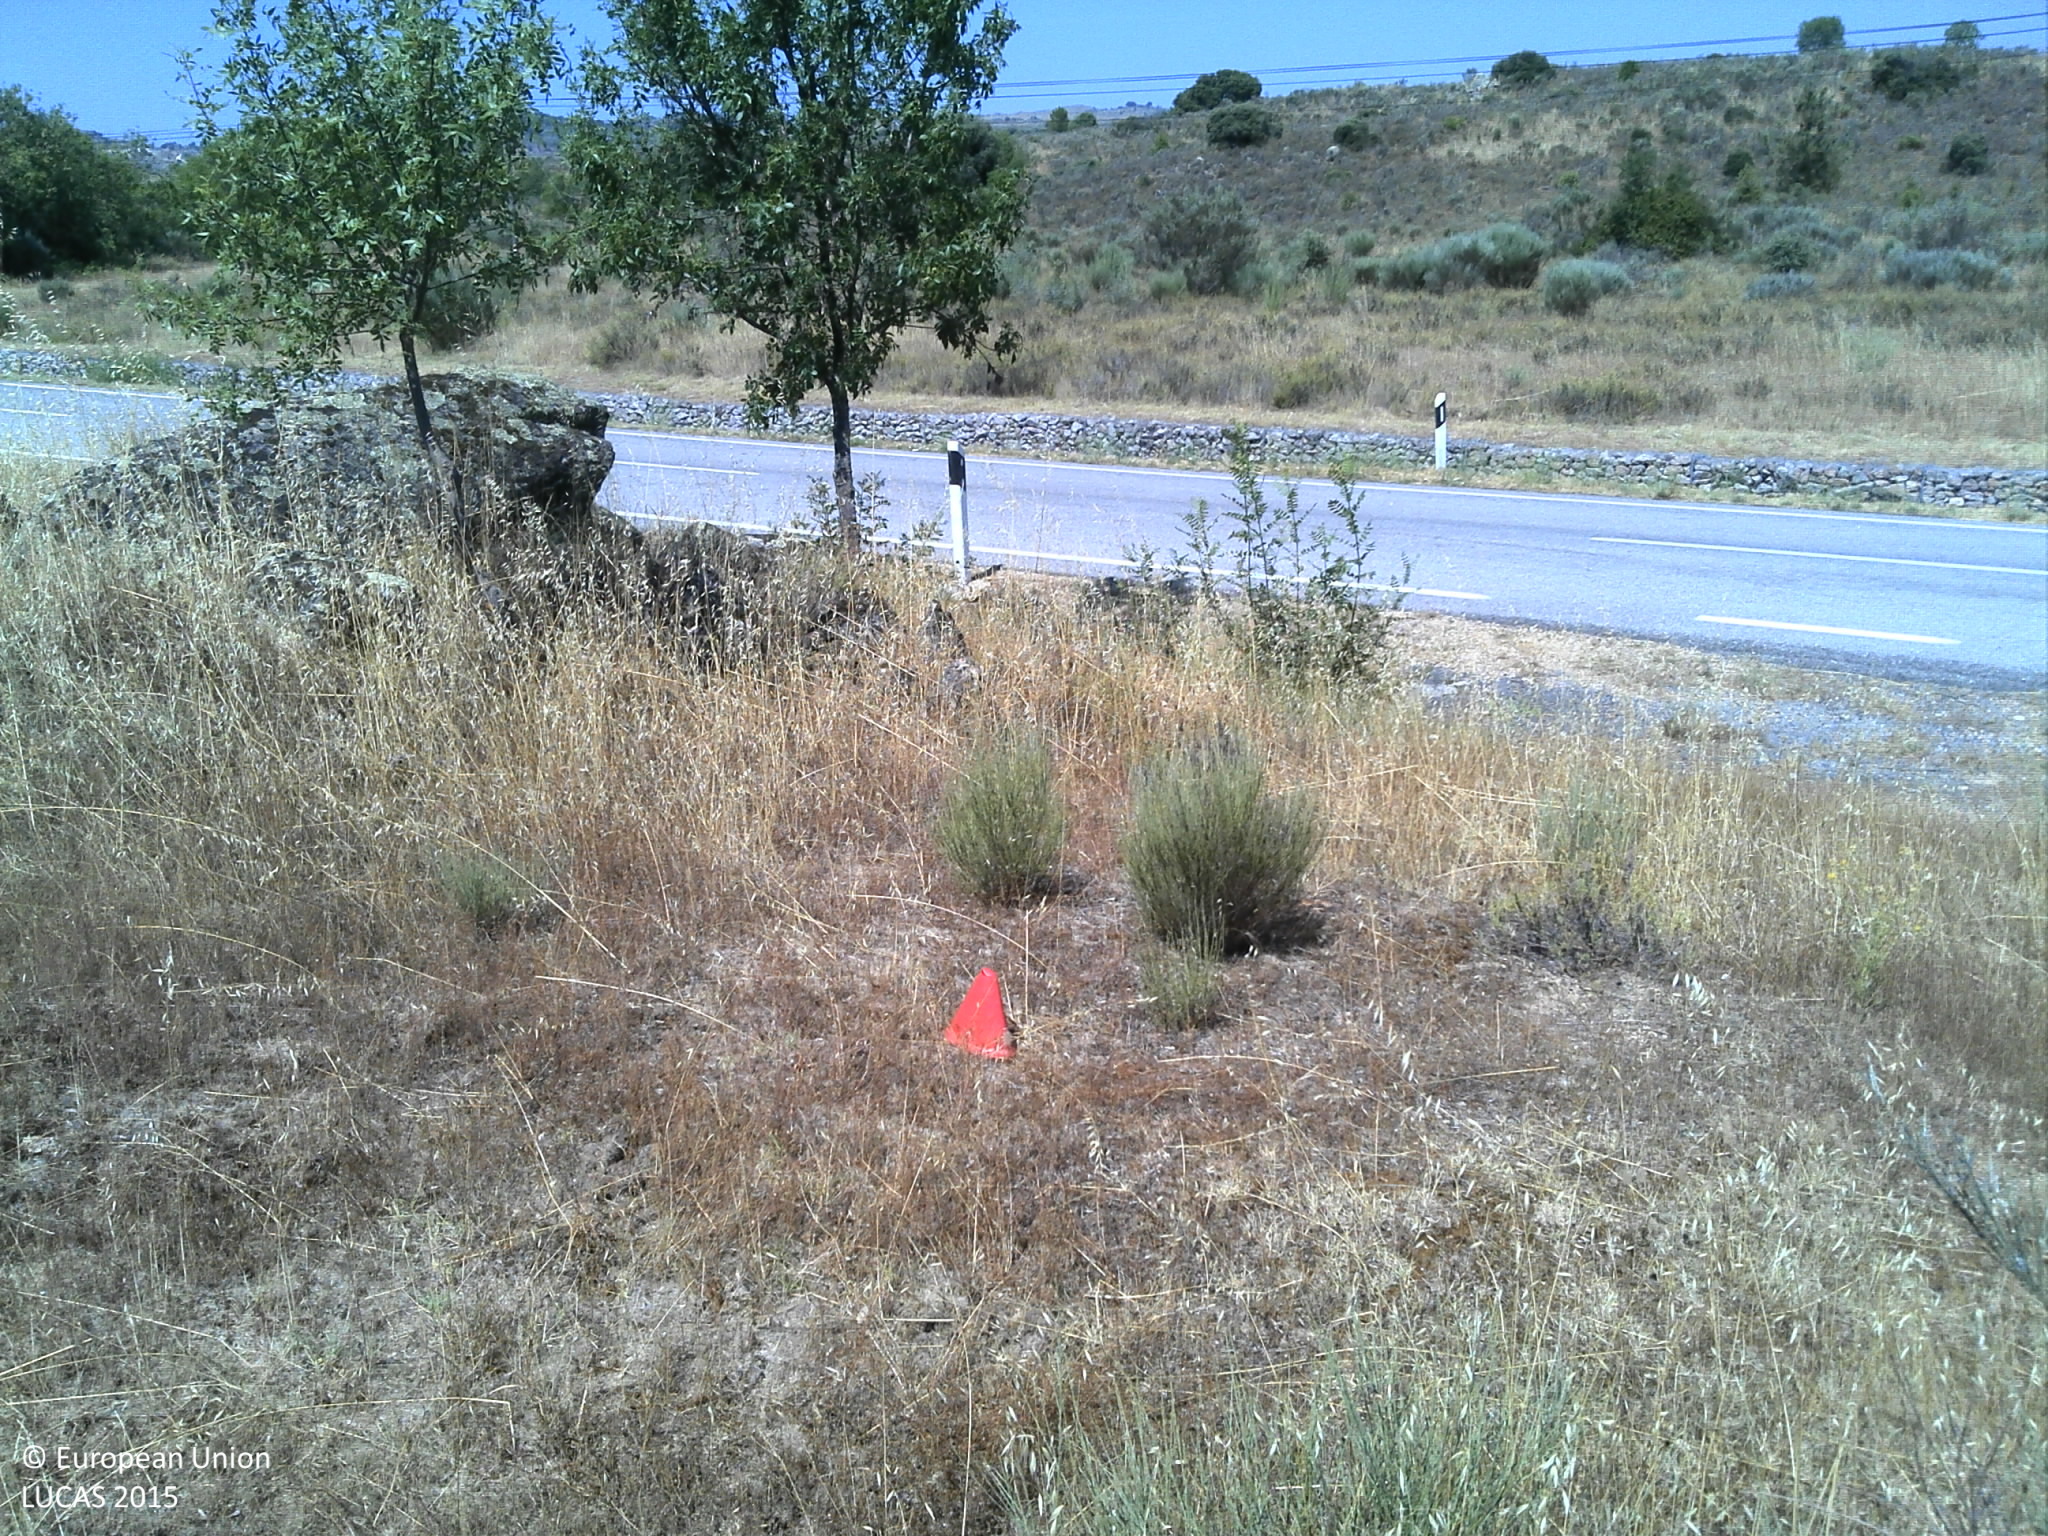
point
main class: Shrubland
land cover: Shrubland with sparse tree cover
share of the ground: > 75 %
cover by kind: shrubs 95 %, broadleaved forest trees 5 %
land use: Semi-natural and natural areas not in use
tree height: < 5 m
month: July
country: PT
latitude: 40.9300
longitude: -7.2001
